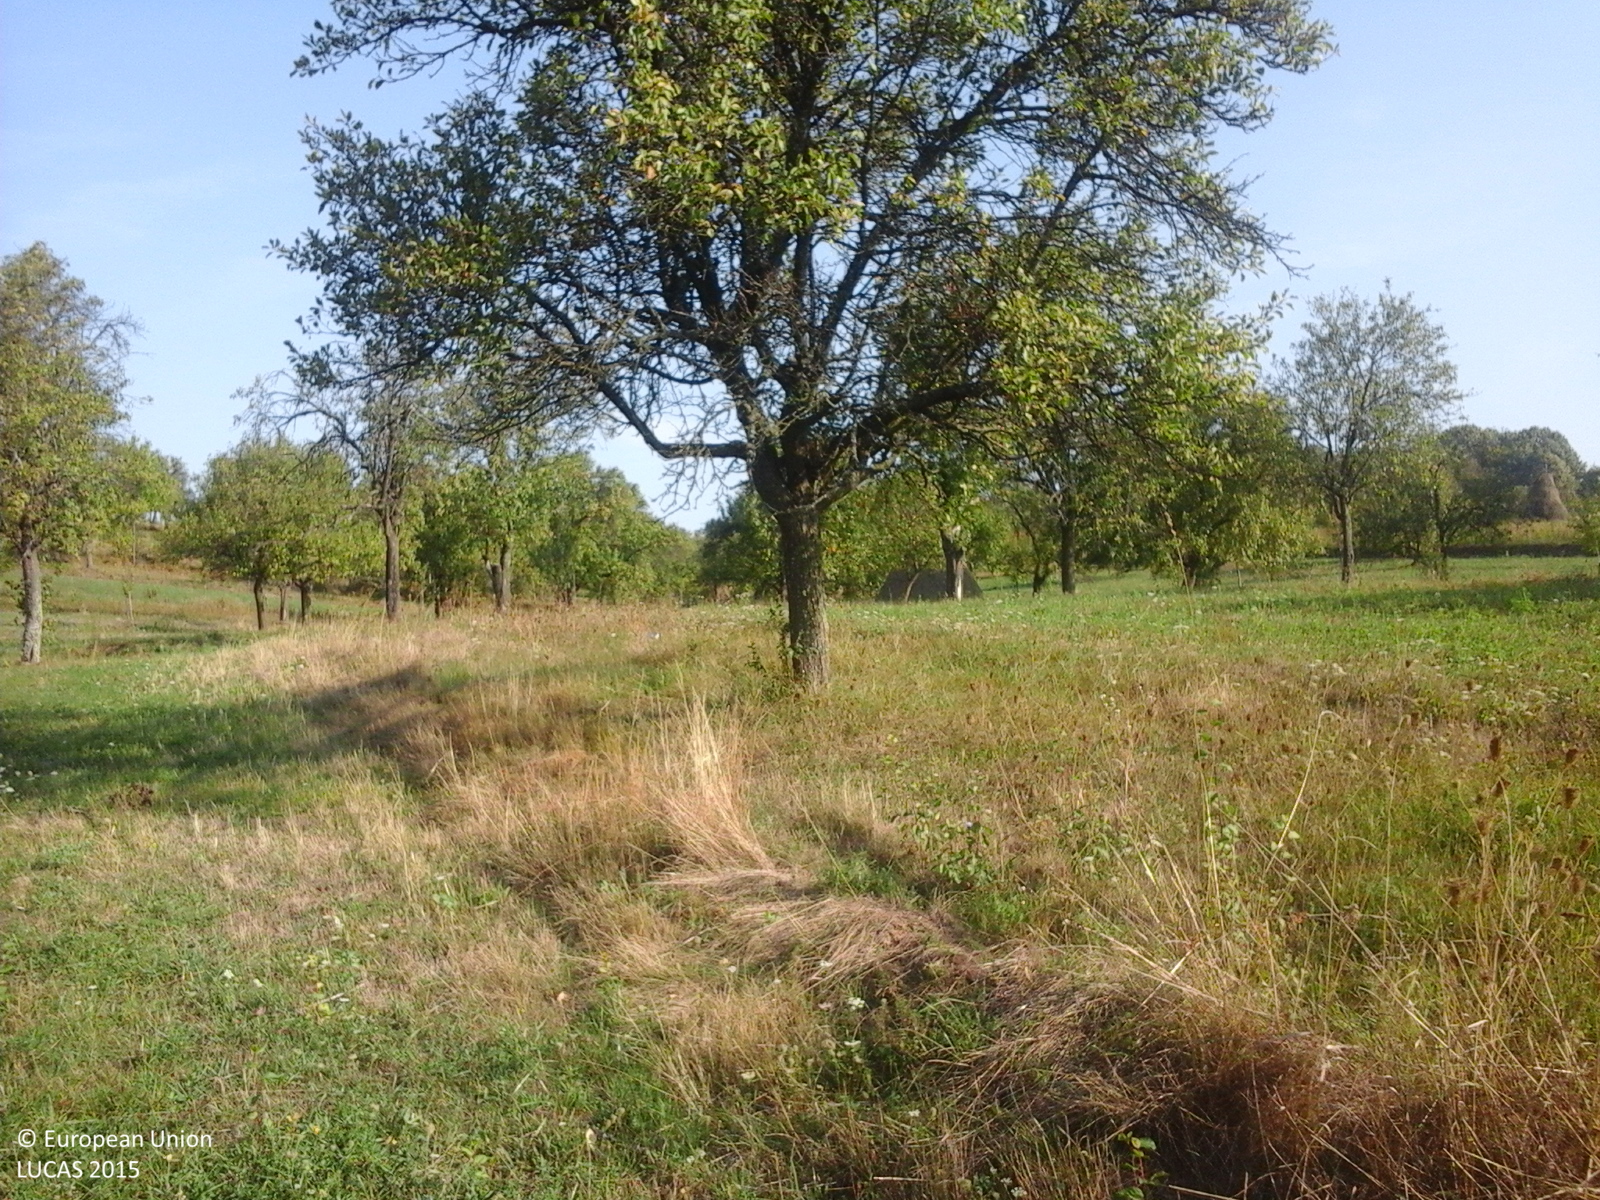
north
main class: Cropland
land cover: Other fruit trees and berries
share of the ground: 50 - 75 %
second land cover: Grassland without tree/shrub cover
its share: > 75 %
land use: Agriculture (excluding fallow land and kitchen gardens)
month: September
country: RO
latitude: 45.0946
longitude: 22.2762
